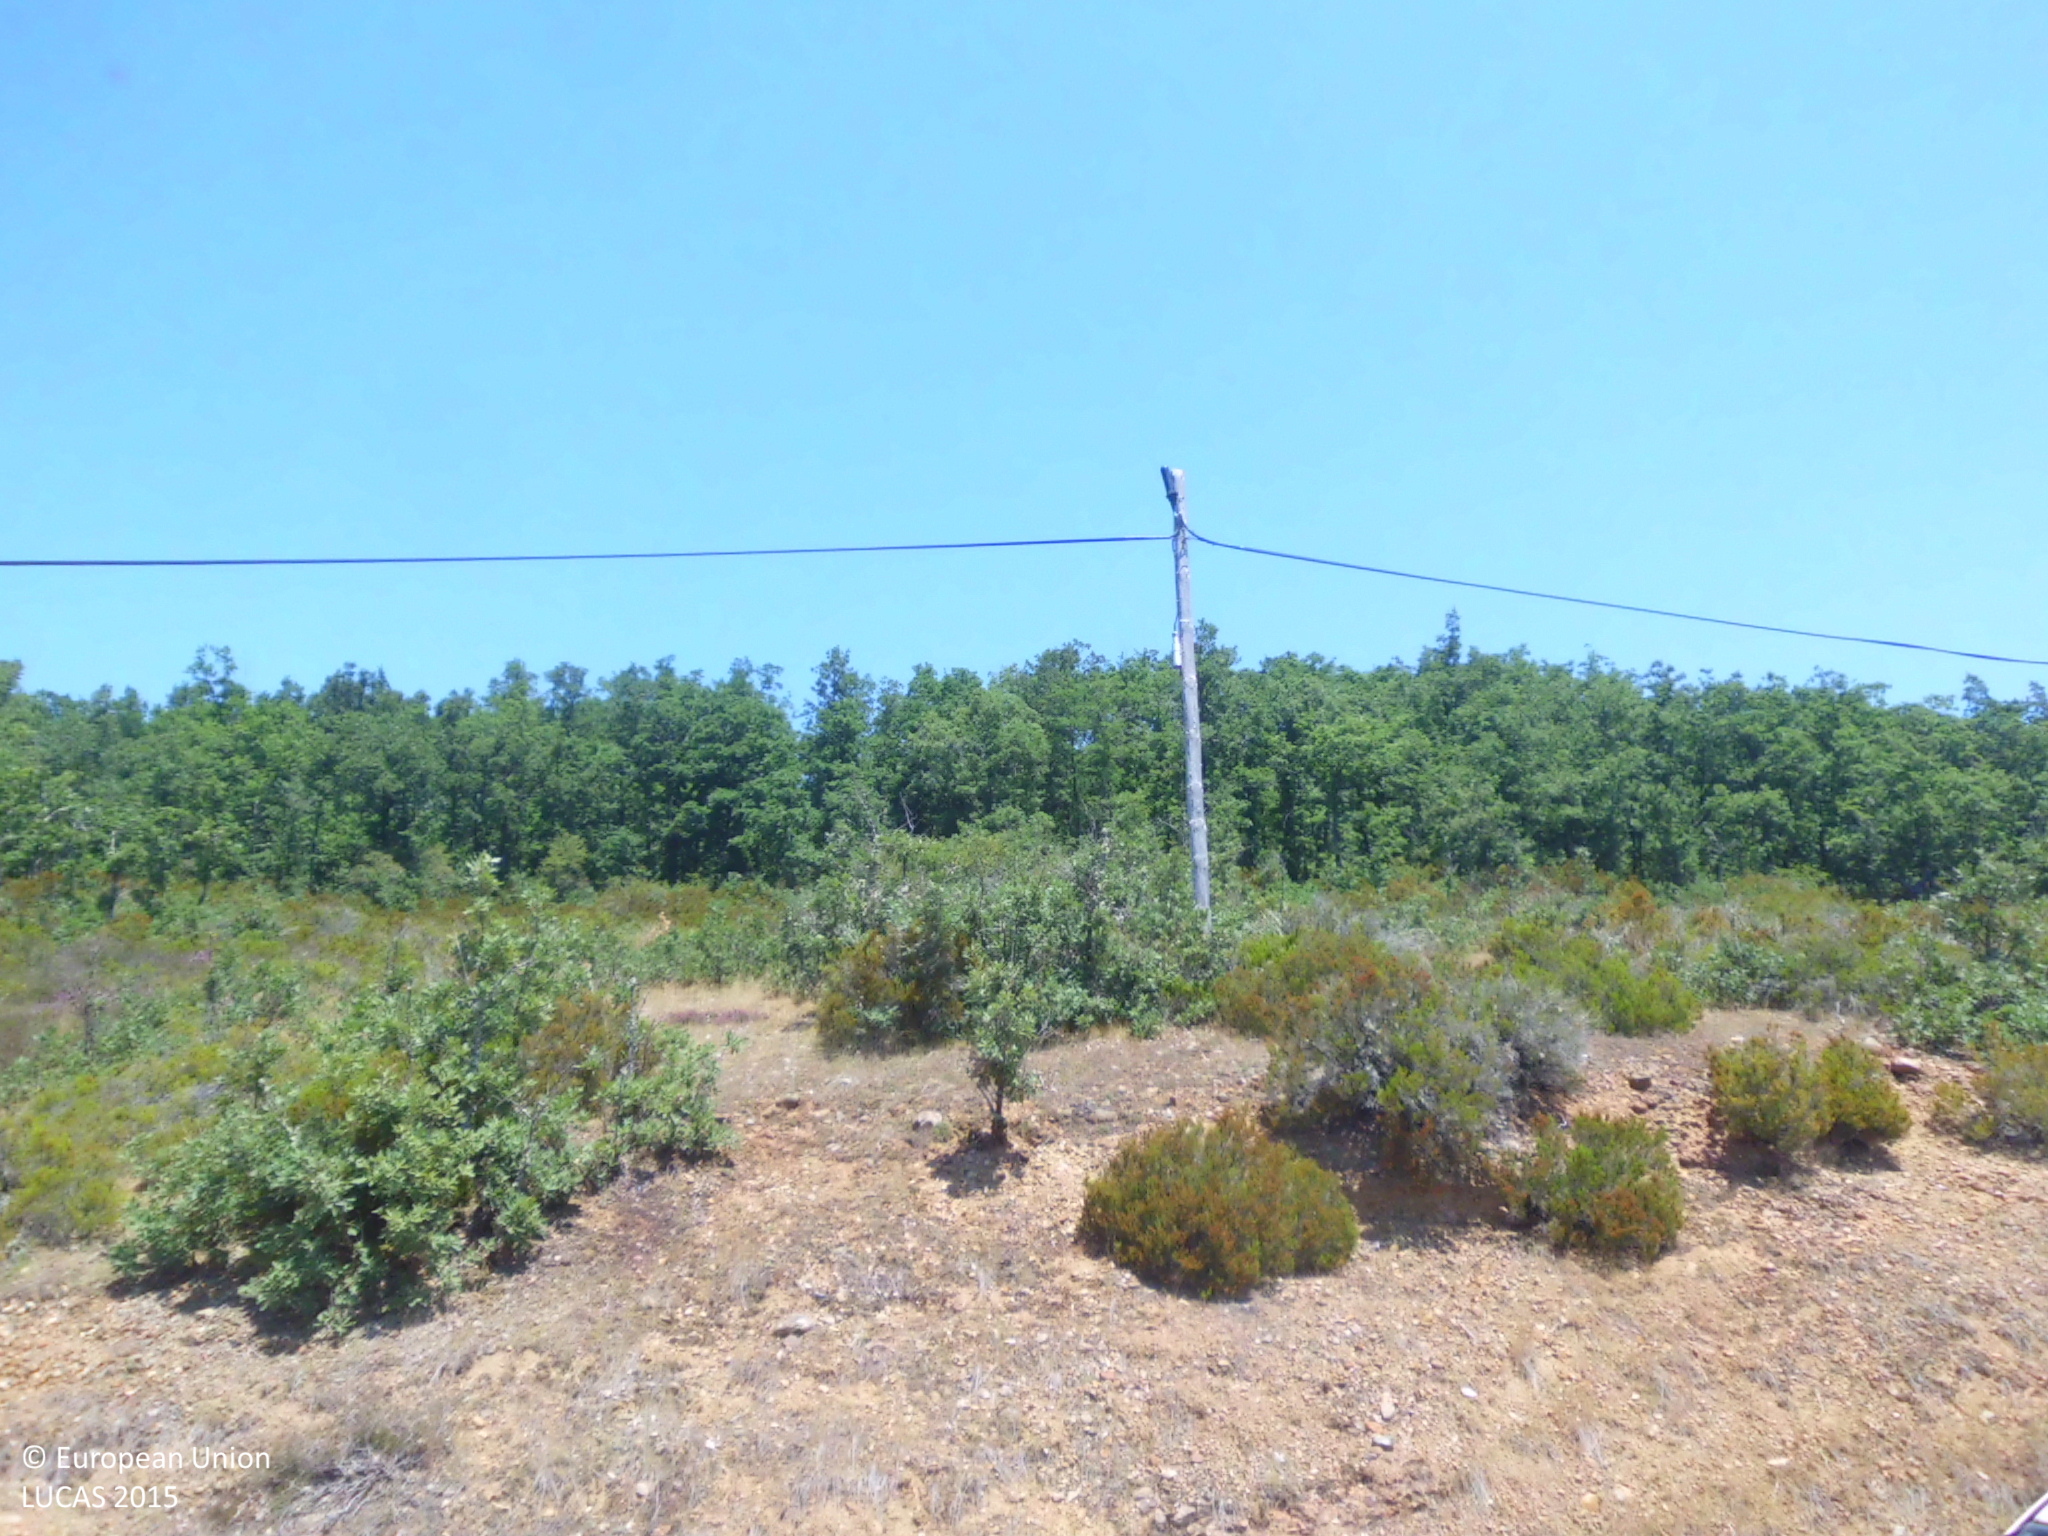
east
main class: Woodland
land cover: Pine dominated coniferous woodland
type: coniferous forest of the mediterranean region
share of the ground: > 75 %
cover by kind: coniferous forest trees 100 %
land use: Forestry
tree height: > 5 m
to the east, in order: Pine dominated coniferous woodland
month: July
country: ES
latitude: 42.2413
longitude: -3.3485
